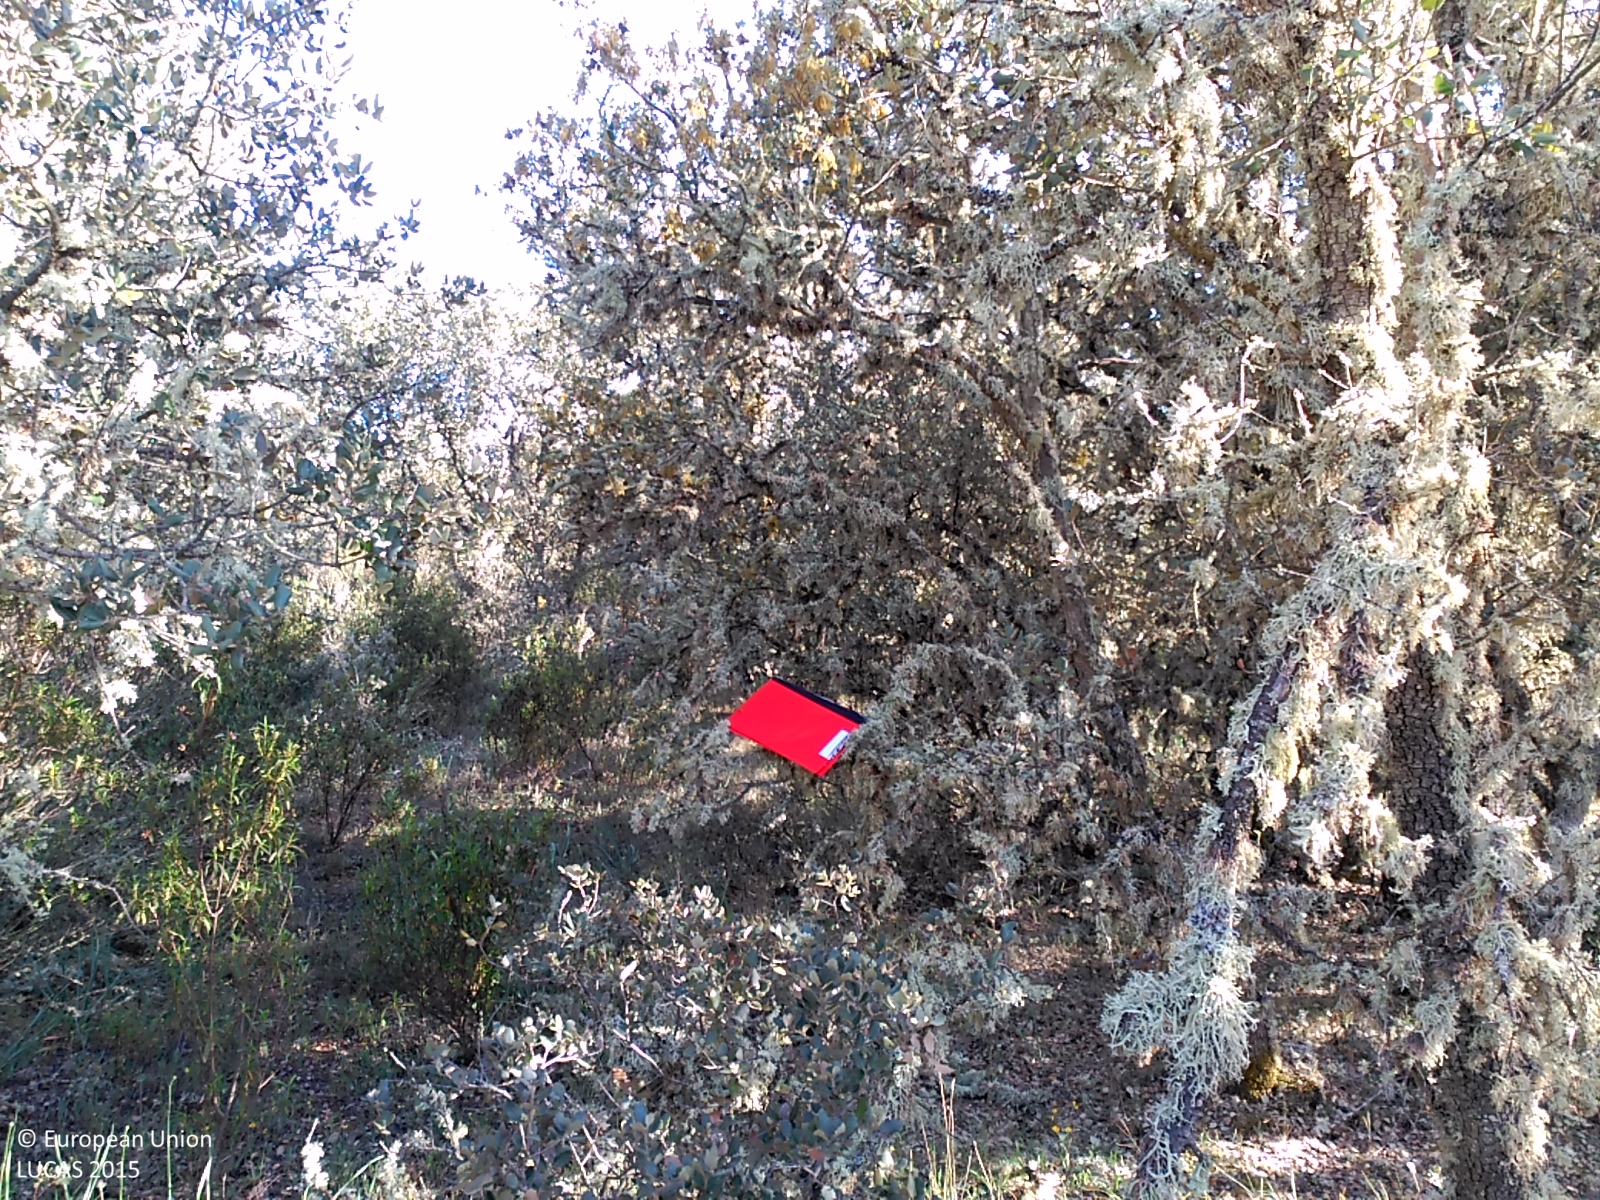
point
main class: Woodland
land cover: Broadleaved woodland
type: broadleaved evergreen forest
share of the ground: > 75 %
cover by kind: broadleaved forest trees 90 %, shrubs 10 %
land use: Forestry
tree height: > 5 m
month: May
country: ES
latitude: 42.0228
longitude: -5.9552
